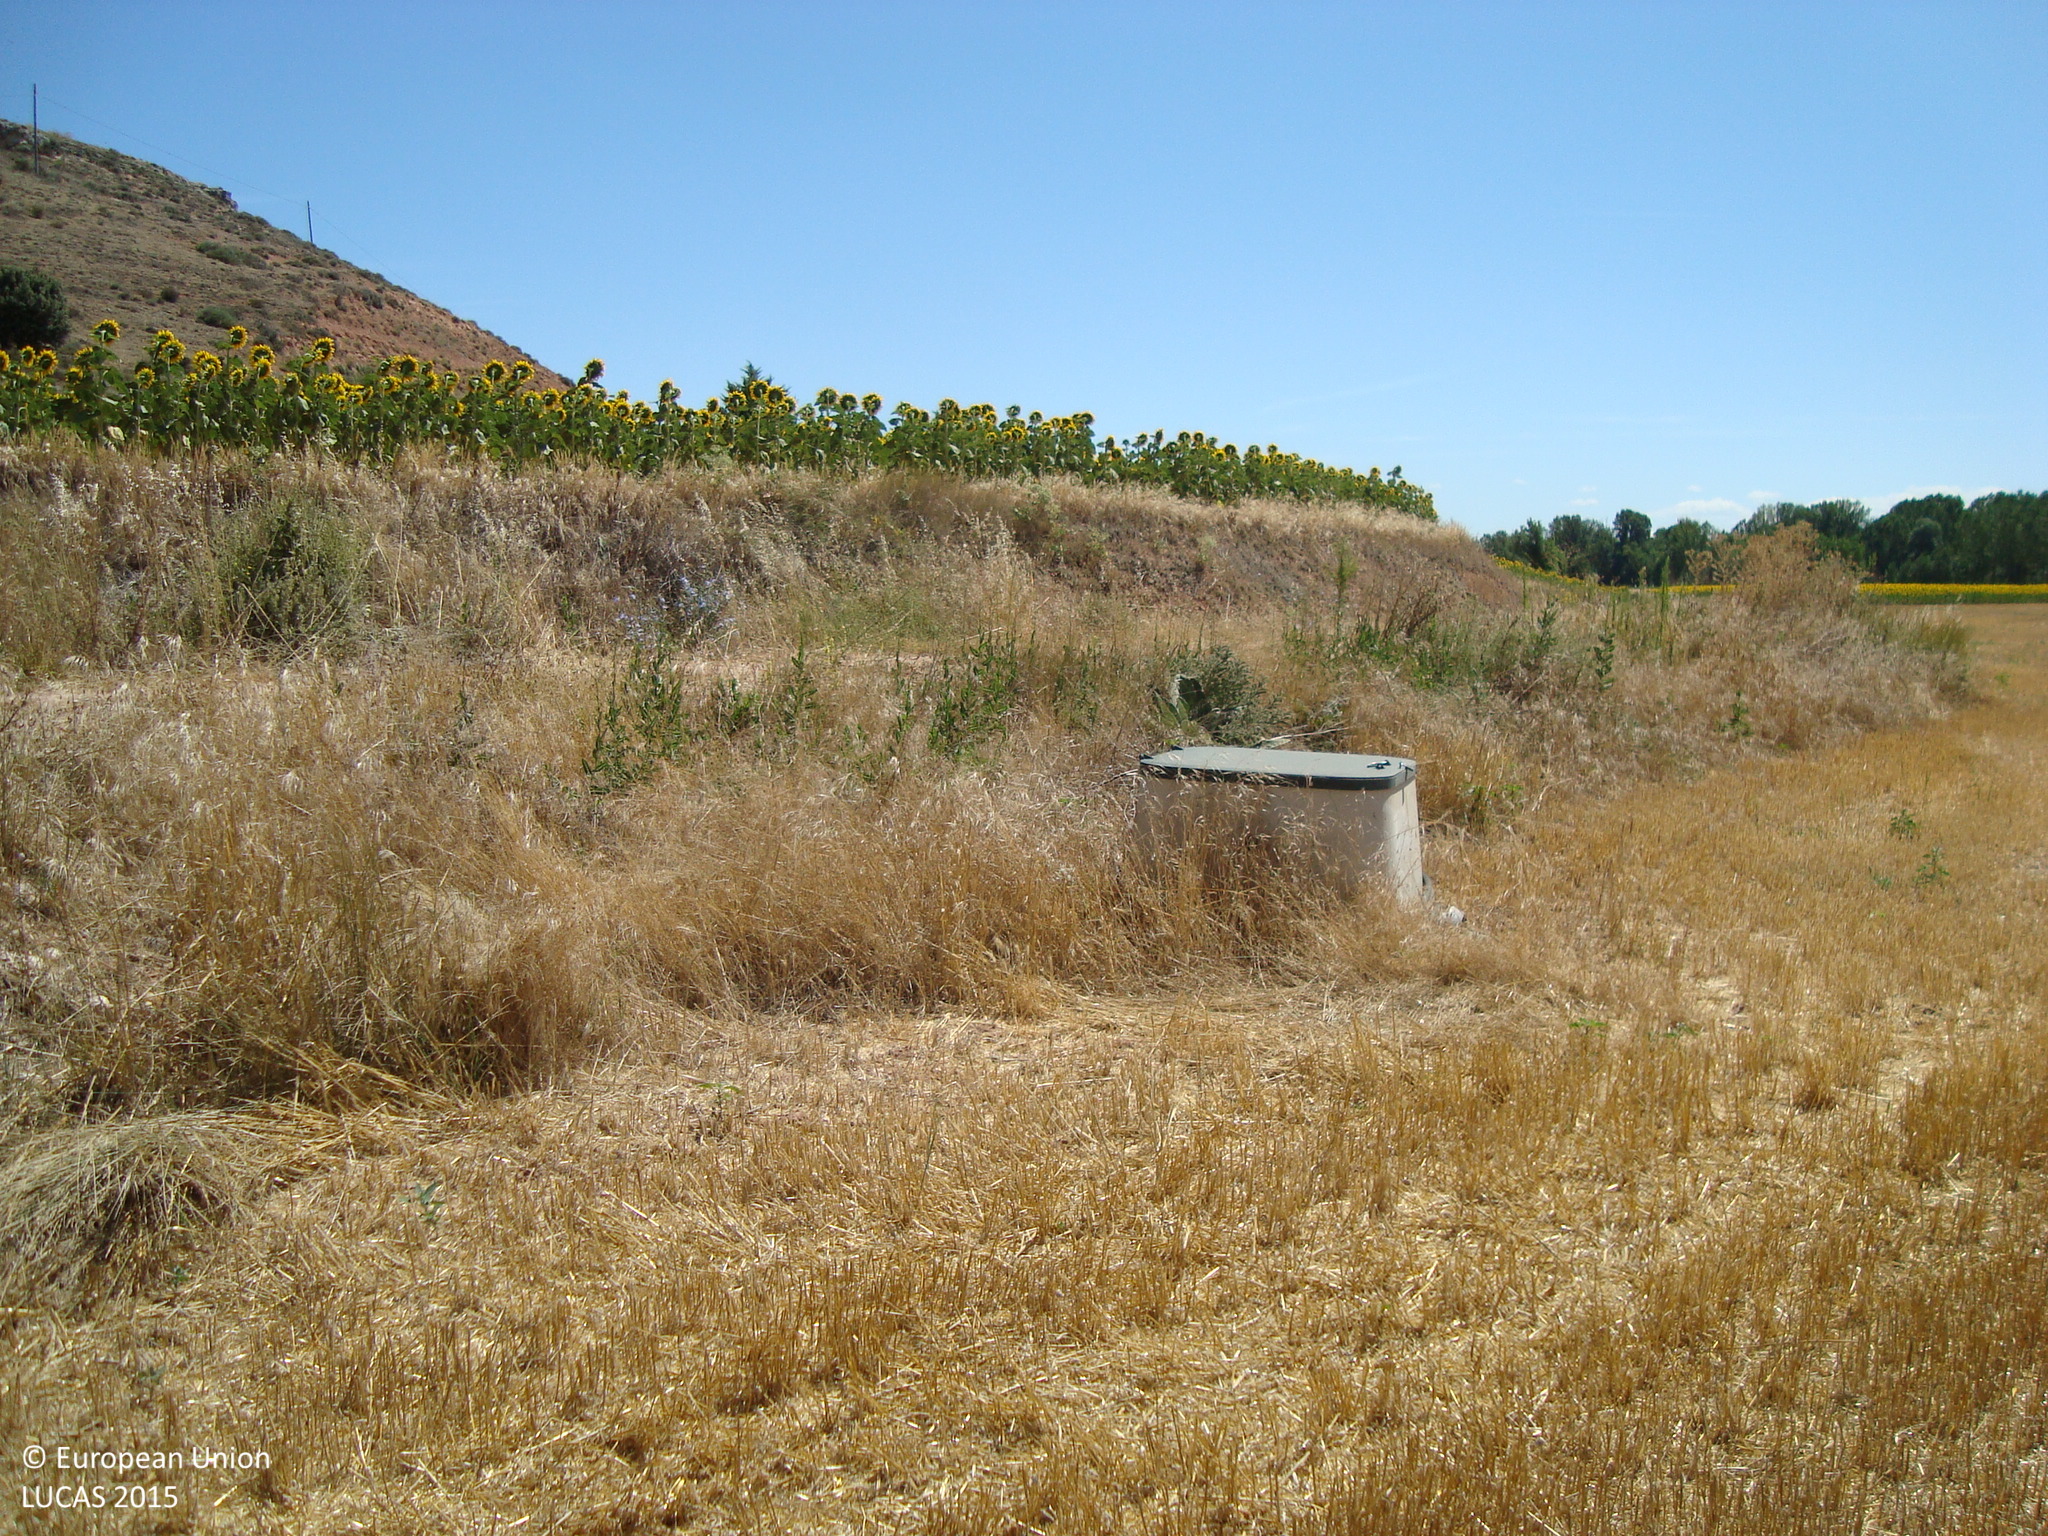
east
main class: Cropland
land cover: Barley
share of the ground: > 75 %
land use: Agriculture (excluding fallow land and kitchen gardens)
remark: Harvested field
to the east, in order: Barley; Spontaneously vegetated surfaces; Tracks; Spontaneously vegetated surfaces; Sunflower
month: July
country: ES
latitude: 42.0458
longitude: -3.8444
